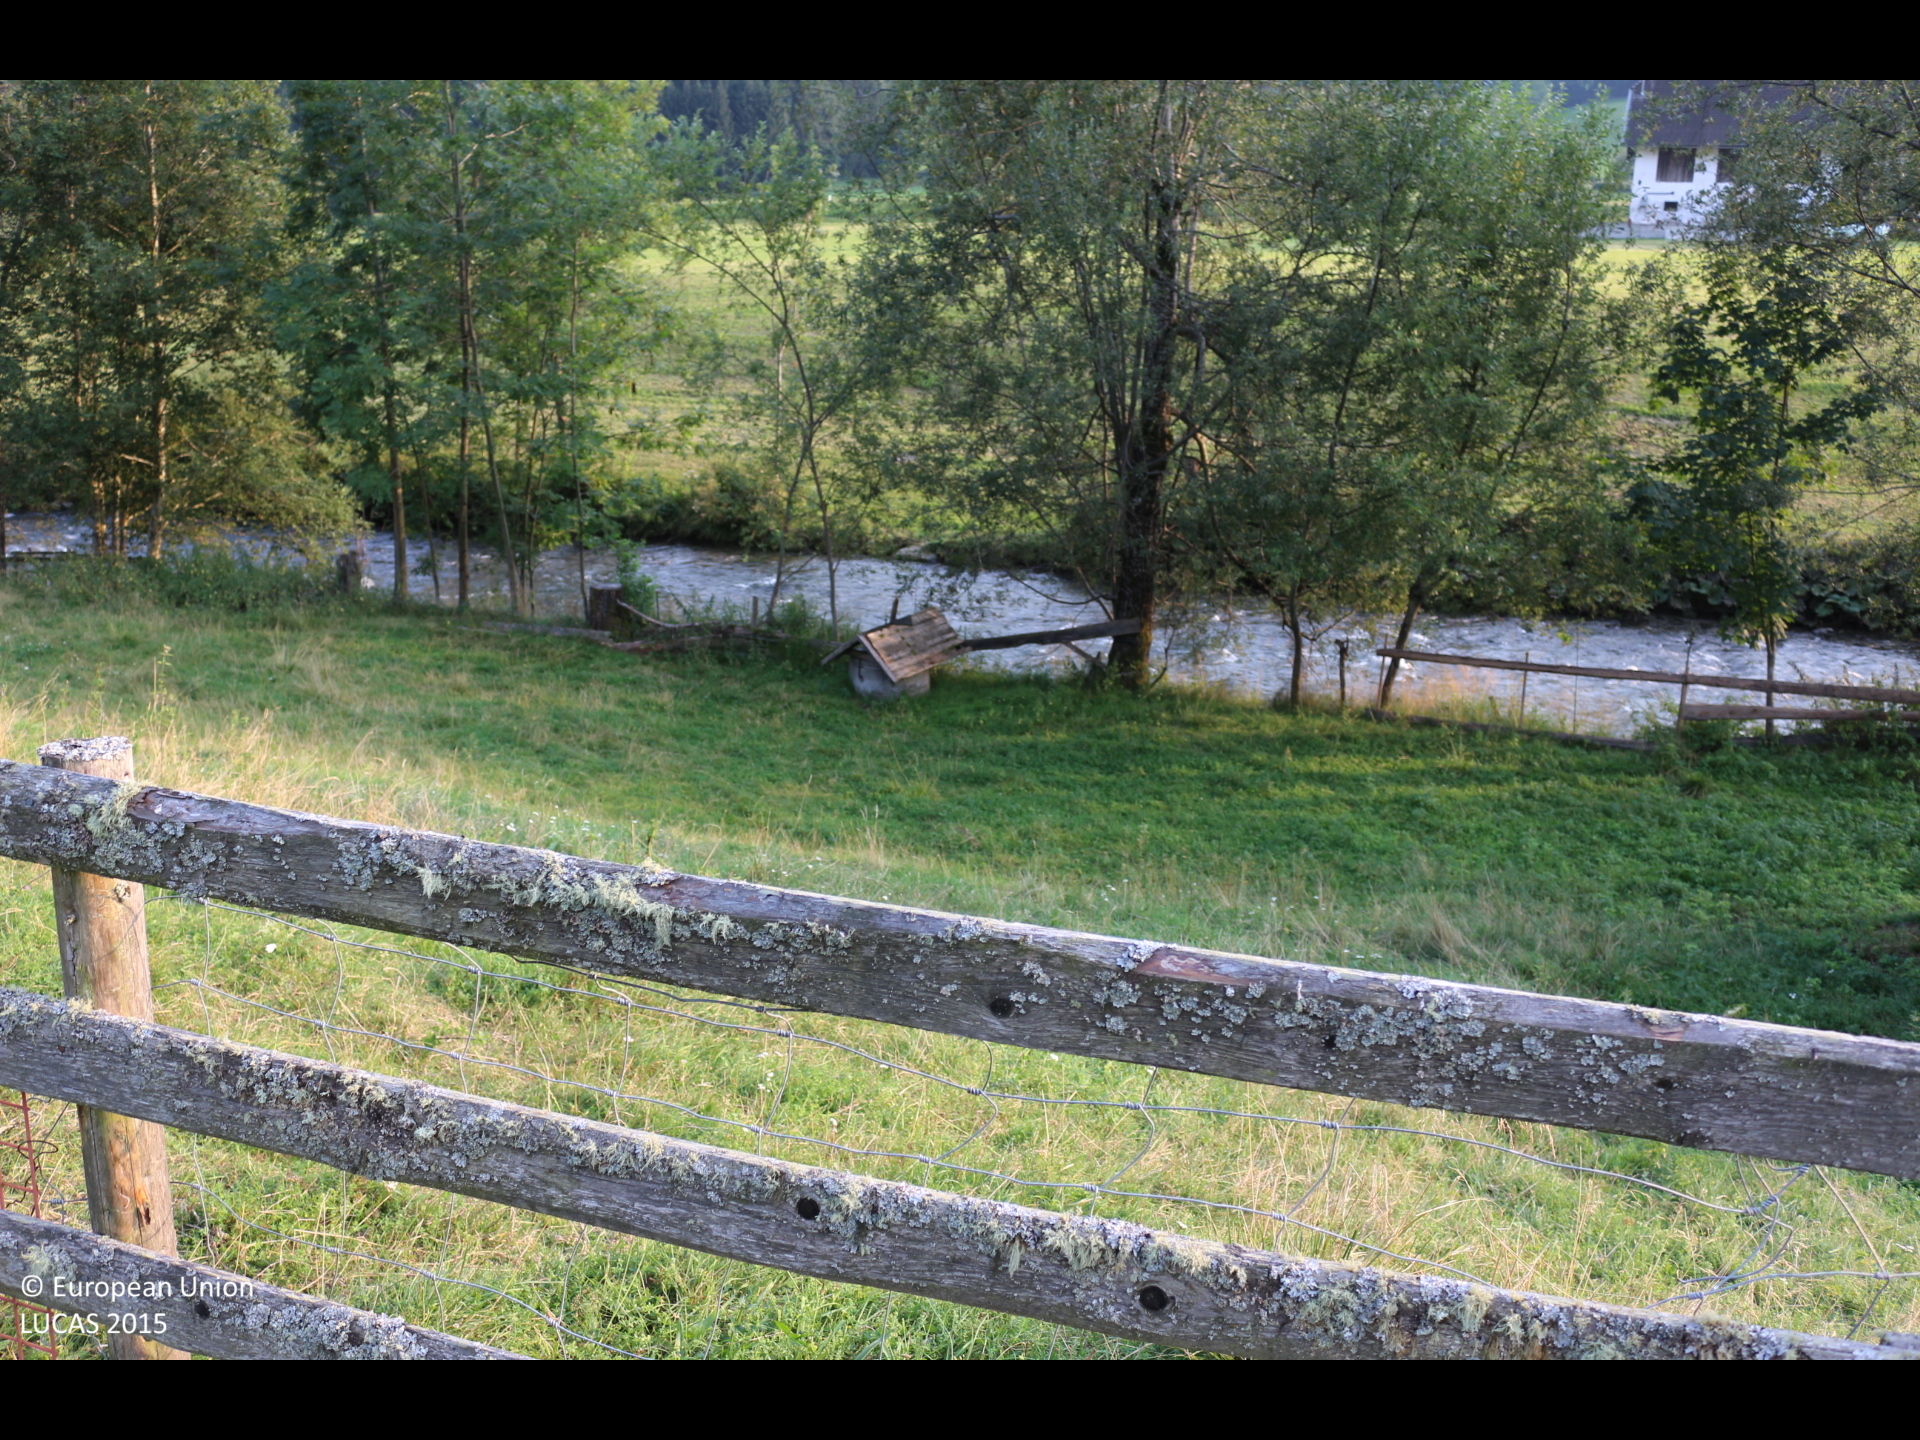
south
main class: Grassland
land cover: Grassland without tree/shrub cover
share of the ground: > 75 %
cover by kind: herbaceous plants 100 %
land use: Agriculture (excluding fallow land and kitchen gardens)
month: August
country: AT
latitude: 46.7835
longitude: 13.9401
